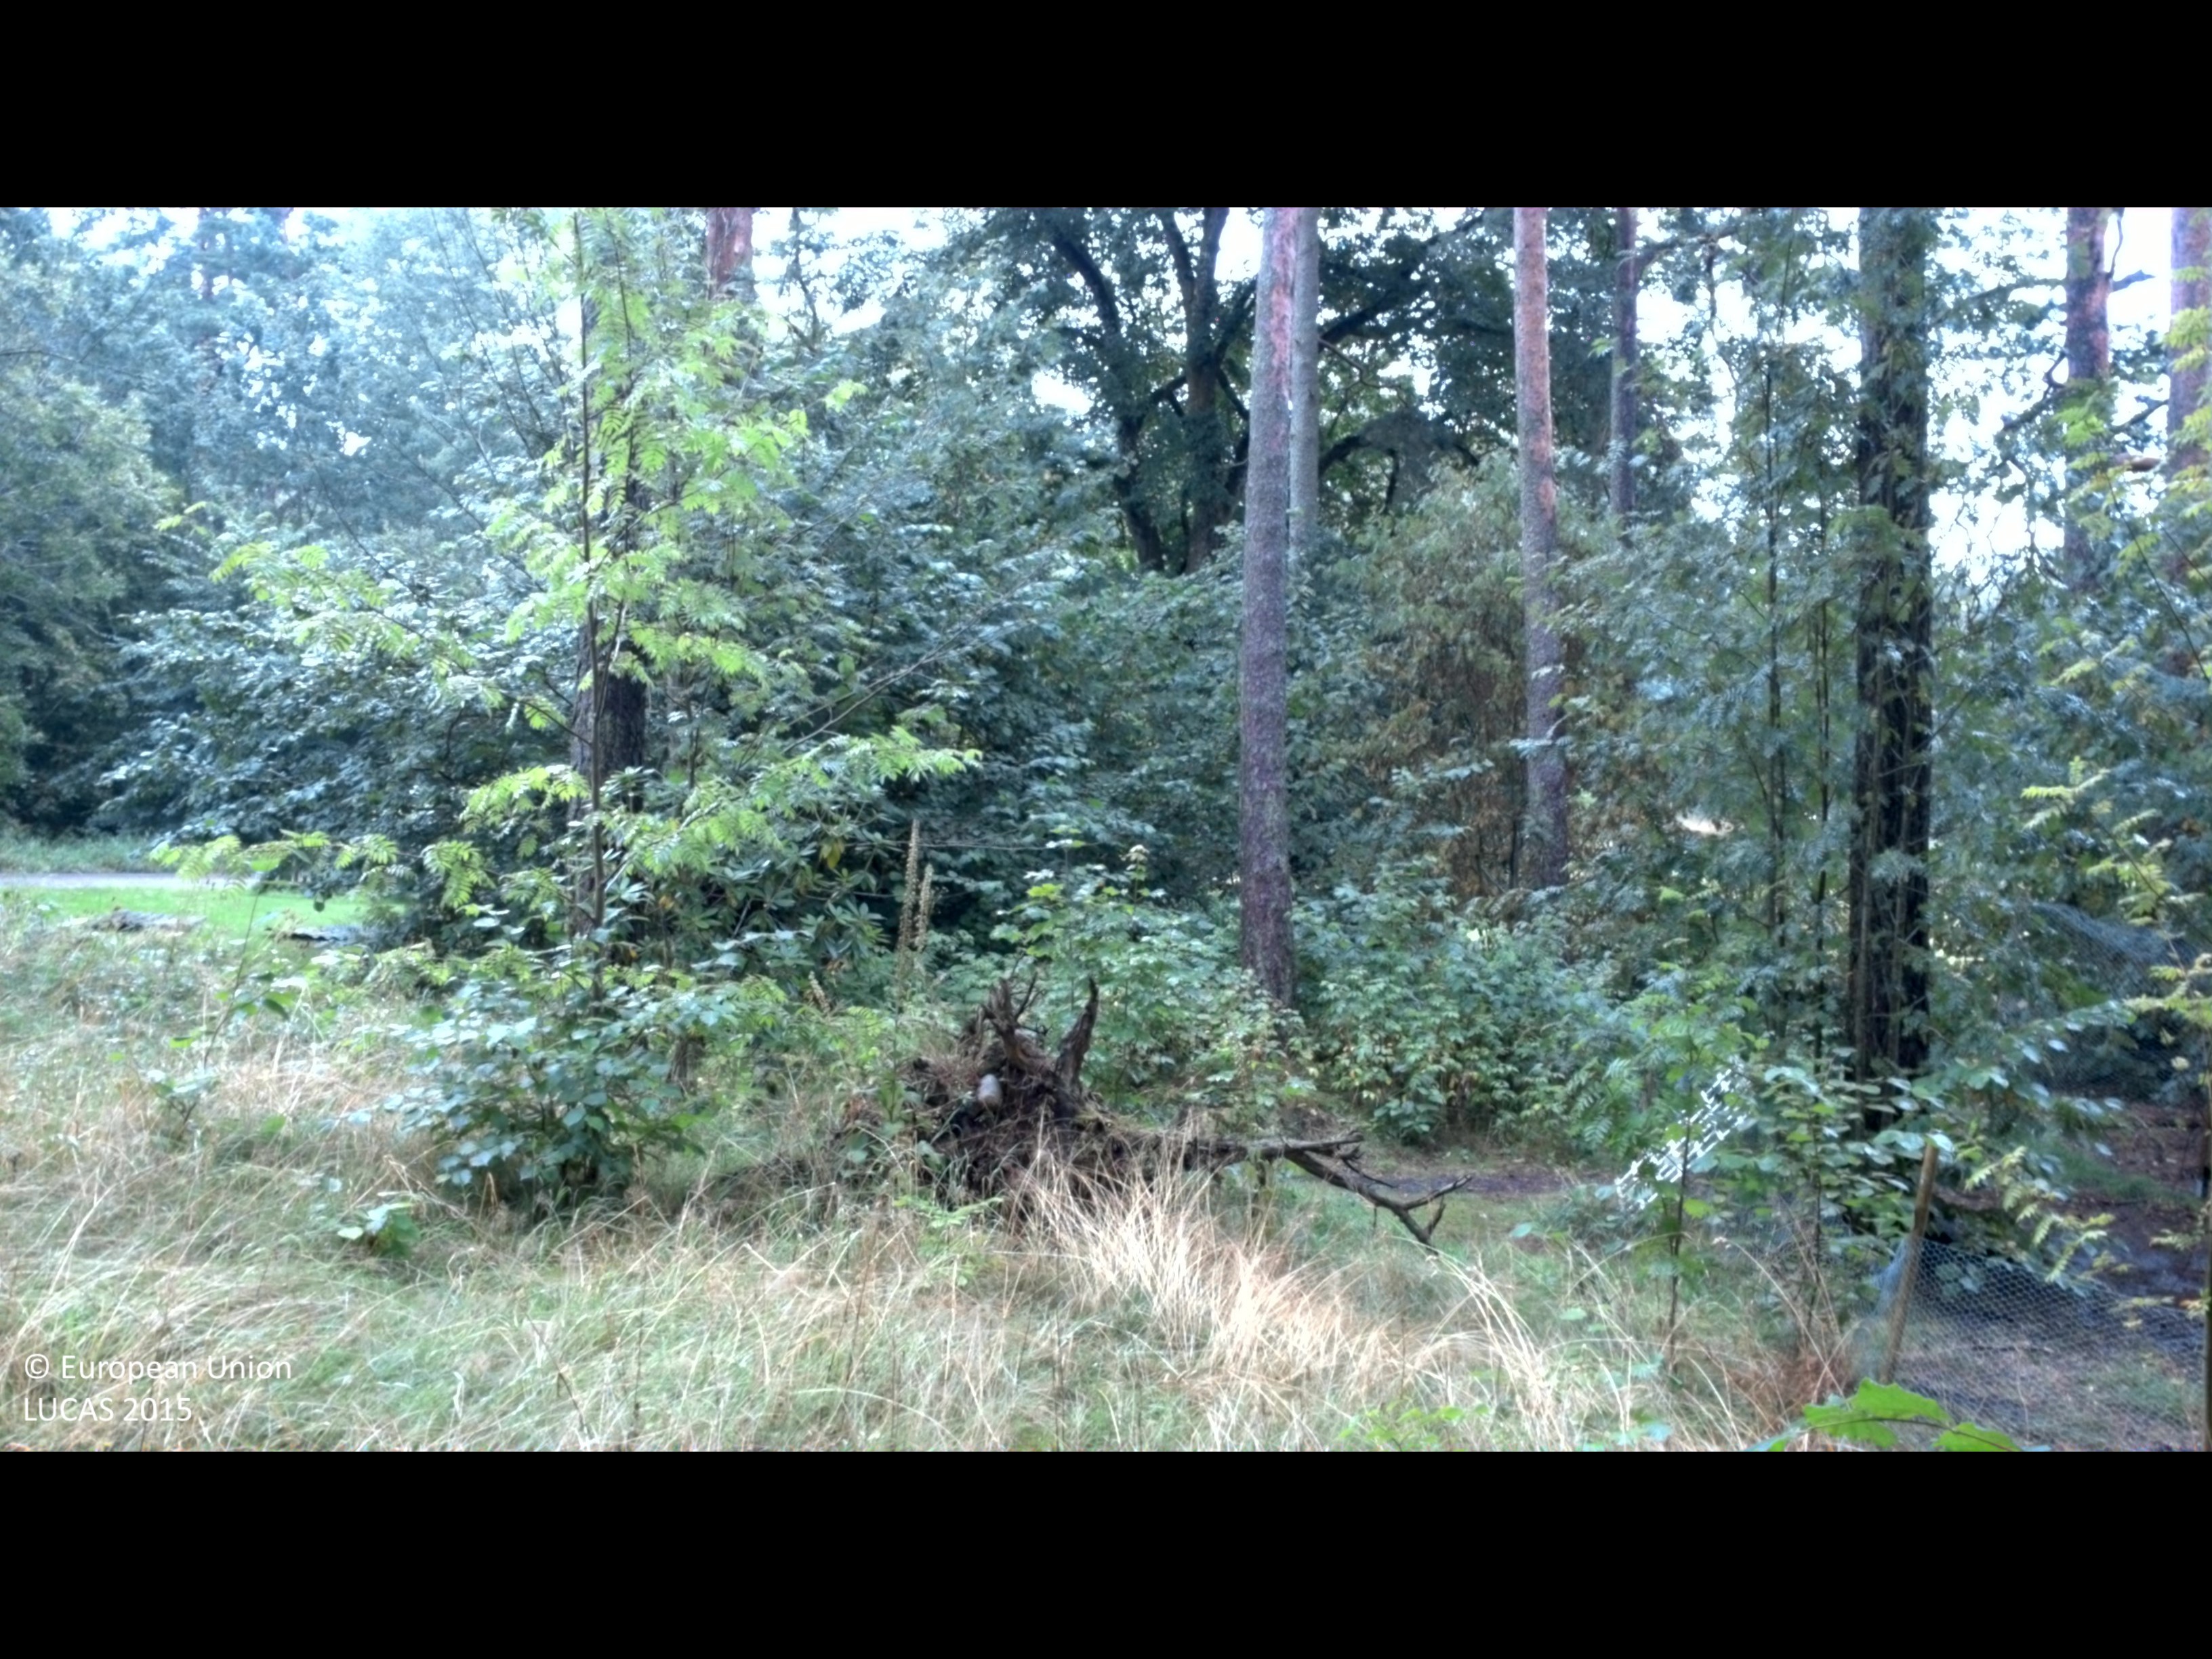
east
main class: Woodland
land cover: Pine dominated mixed woodland
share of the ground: 50 - 75 %
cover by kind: coniferous forest trees 45 %, herbaceous plants 25 %, broadleaved forest trees 20 %, shrubs 10 %
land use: Residential
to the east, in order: Pine dominated mixed woodland; Fences; Grassland without tree/shrub cover; Fences; Grassland with sparse tree/shrub cover; Paved roads, cycling and walking lanes; Grass margins; Electric lines; Broadleaved woodland; Pine dominated mixed woodland; Inland fresh running water; Broadleaved woodland; Inland fresh running water
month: August
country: SE
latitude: 56.9591
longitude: 13.1374
